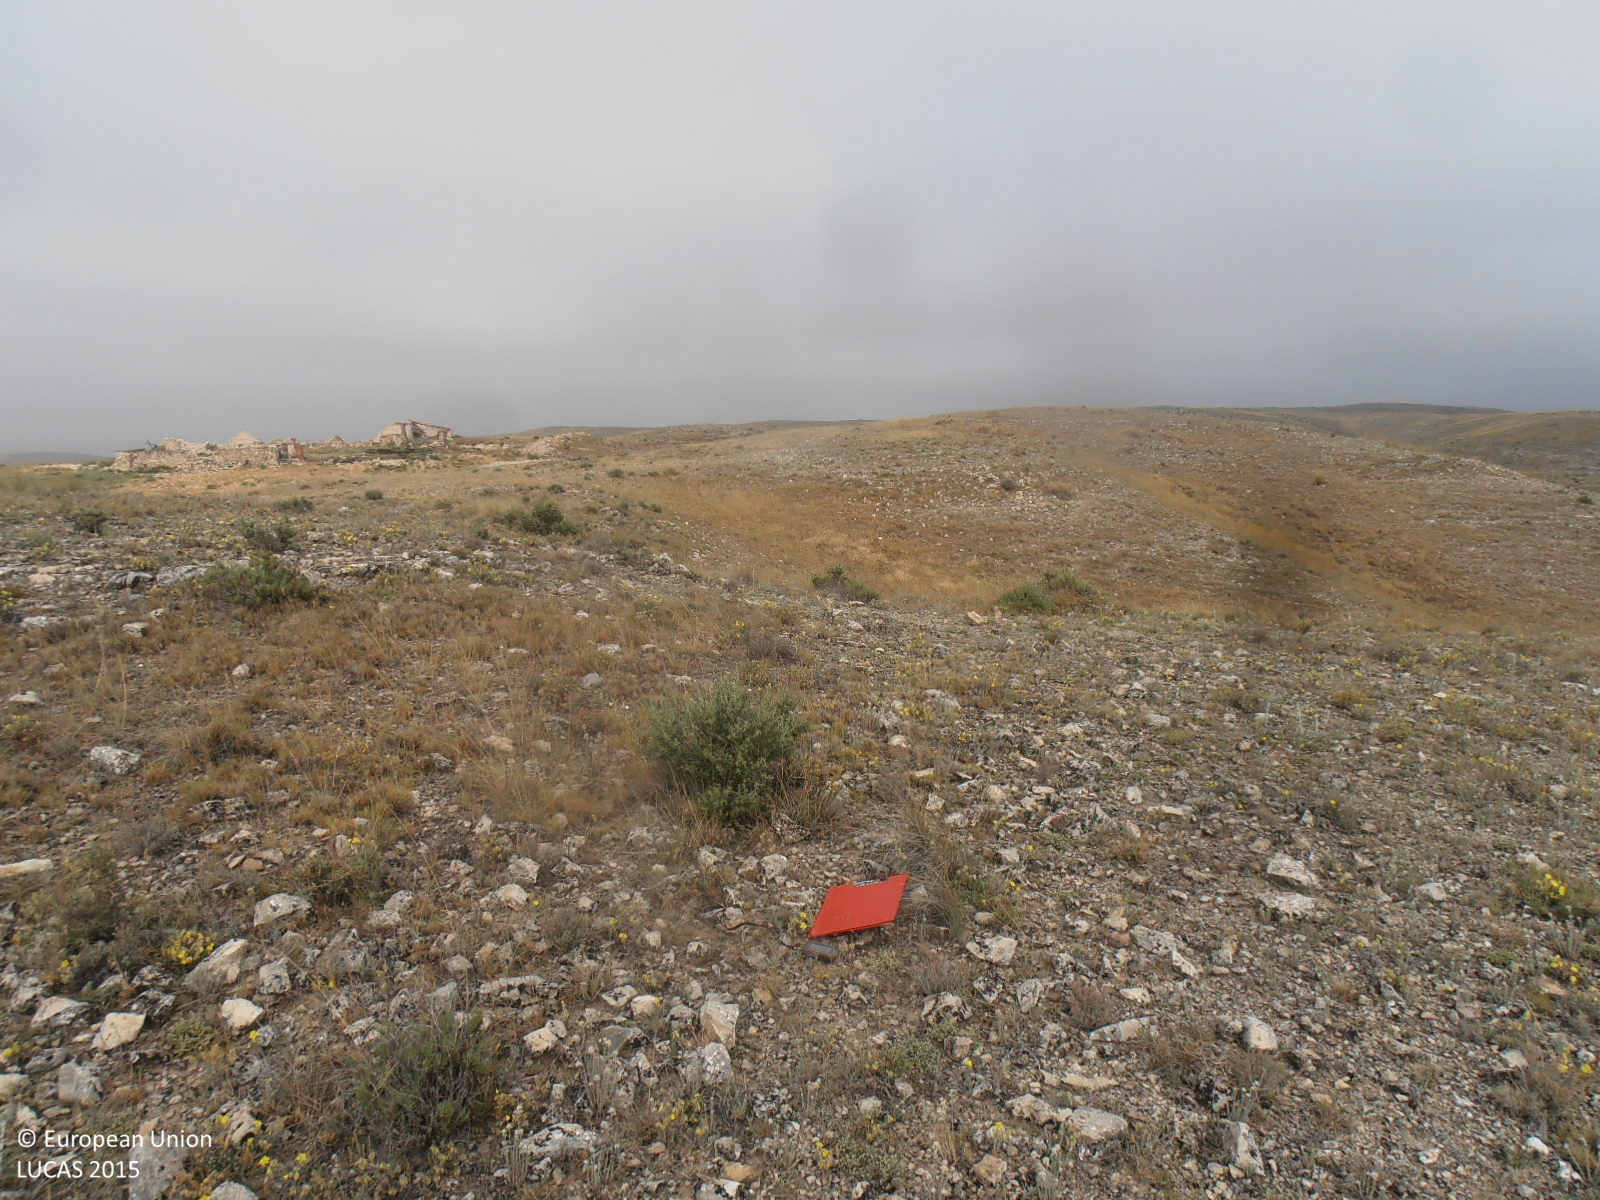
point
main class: Shrubland
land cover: Shrubland without tree cover
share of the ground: > 75 %
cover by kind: shrubs 60 %, herbaceous plants 30 %, consolidated bare surface 10 %
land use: Semi-natural and natural areas not in use
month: June
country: ES
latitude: 41.6247
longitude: -1.2468
